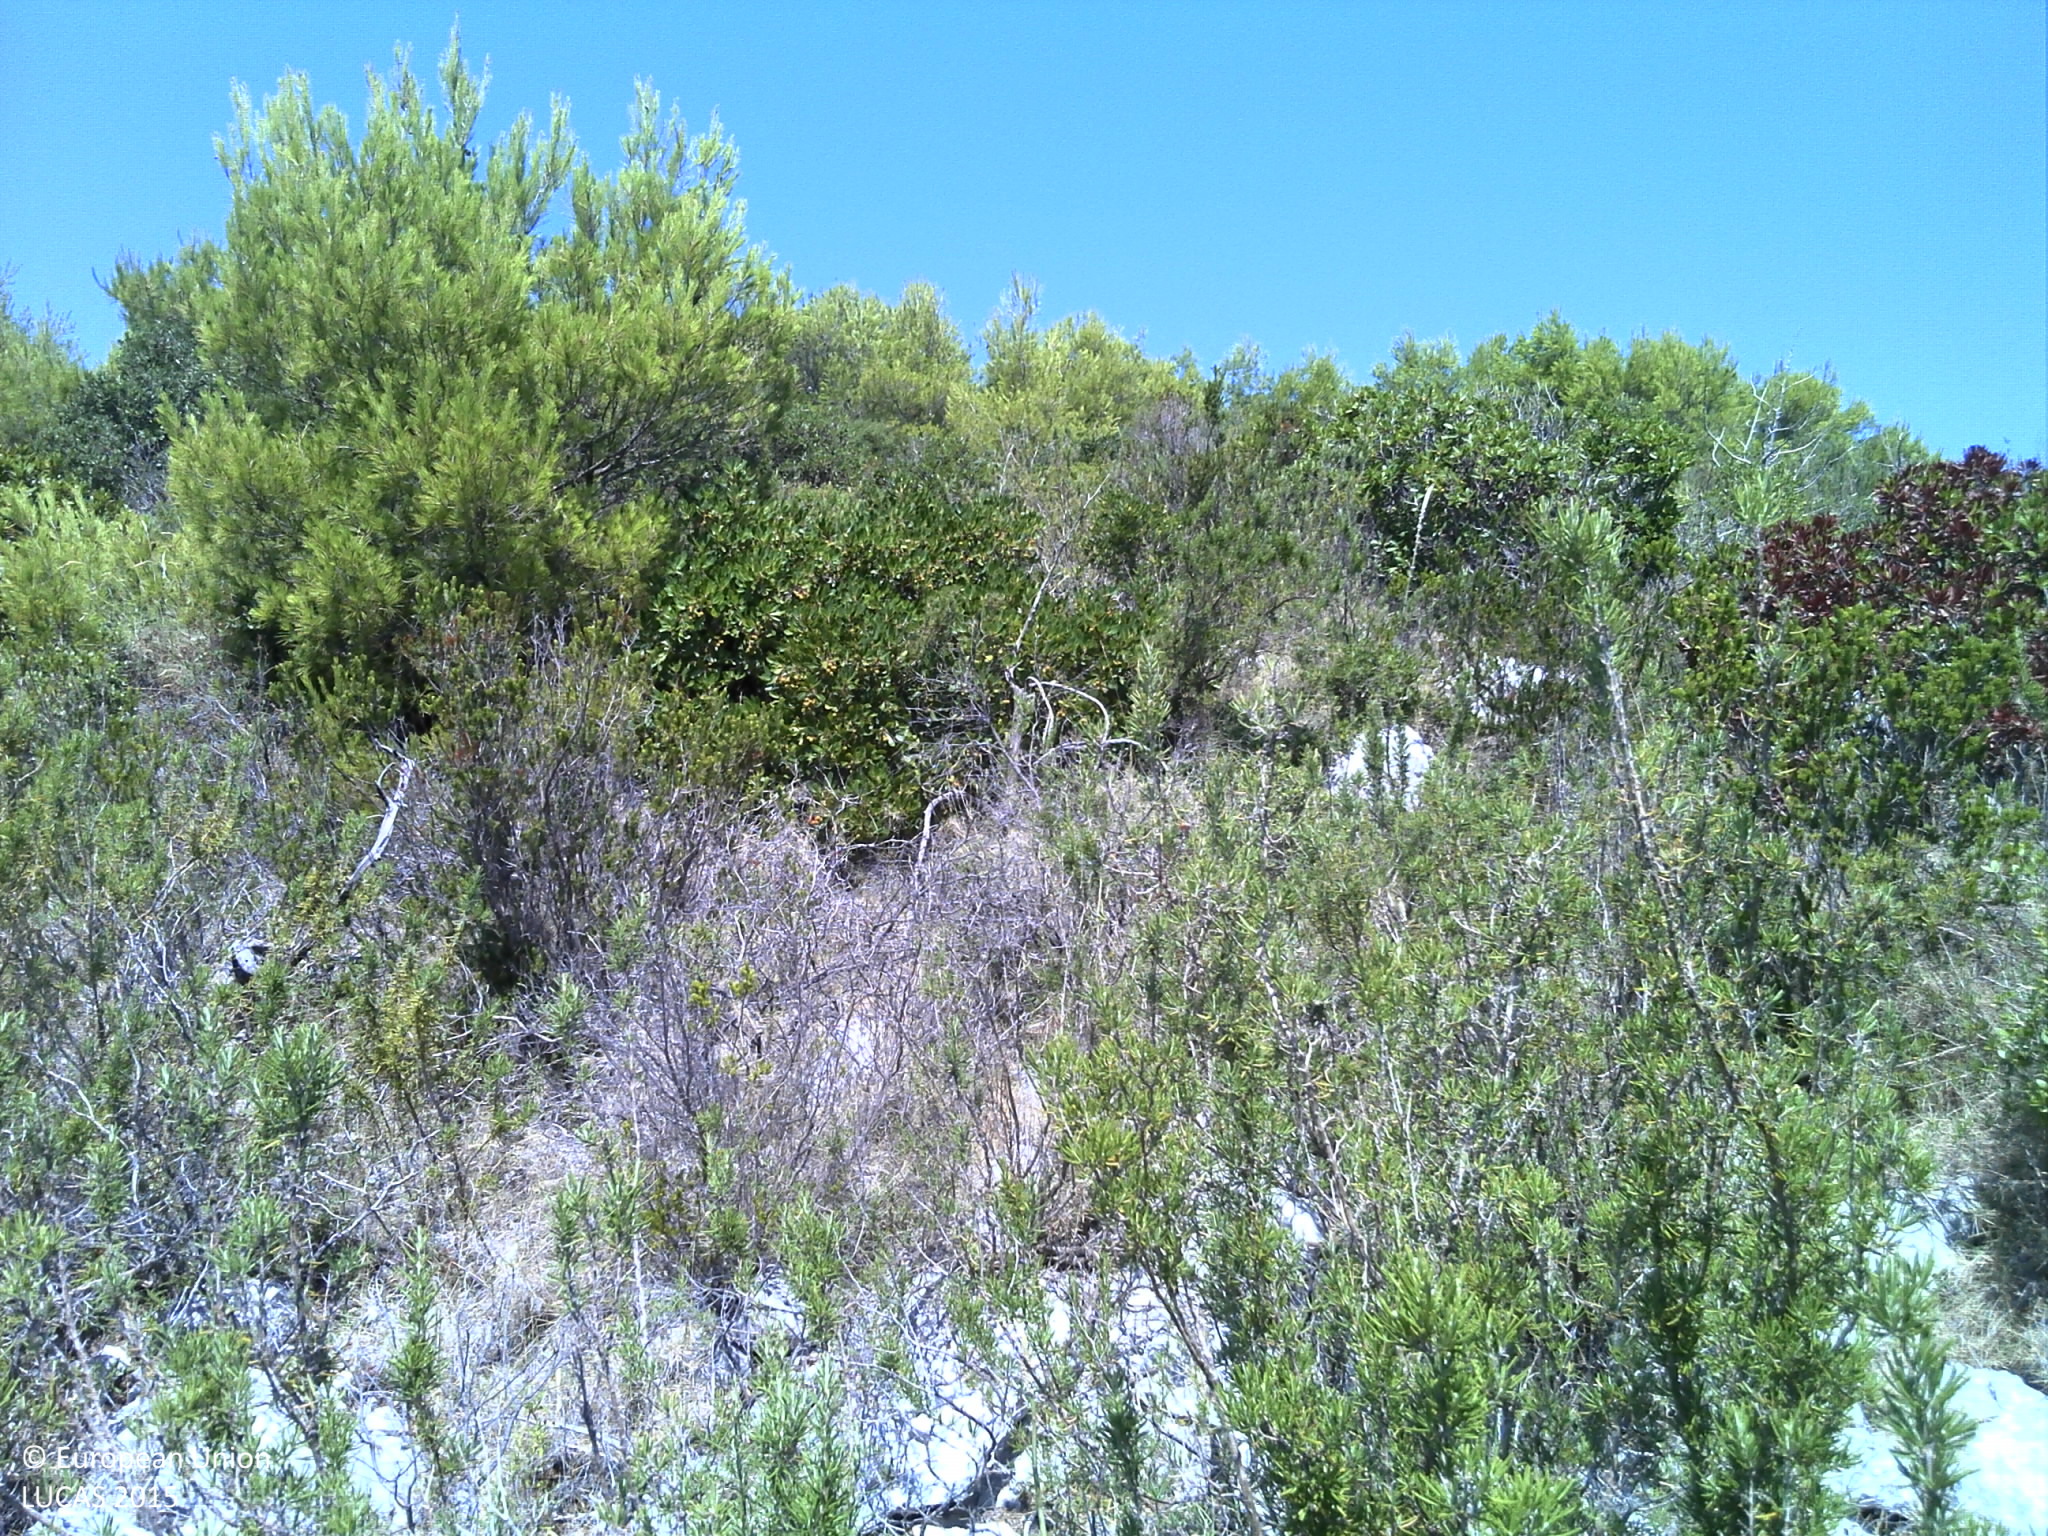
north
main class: Shrubland
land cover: Shrubland with sparse tree cover
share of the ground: > 75 %
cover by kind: shrubs 75 %, unconsolidated bare surface 10 %, coniferous forest trees 5 %, herbaceous plants 5 %, consolidated bare surface 5 %
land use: Semi-natural and natural areas not in use
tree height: > 5 m
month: August
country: HR
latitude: 43.0246
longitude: 16.2102
